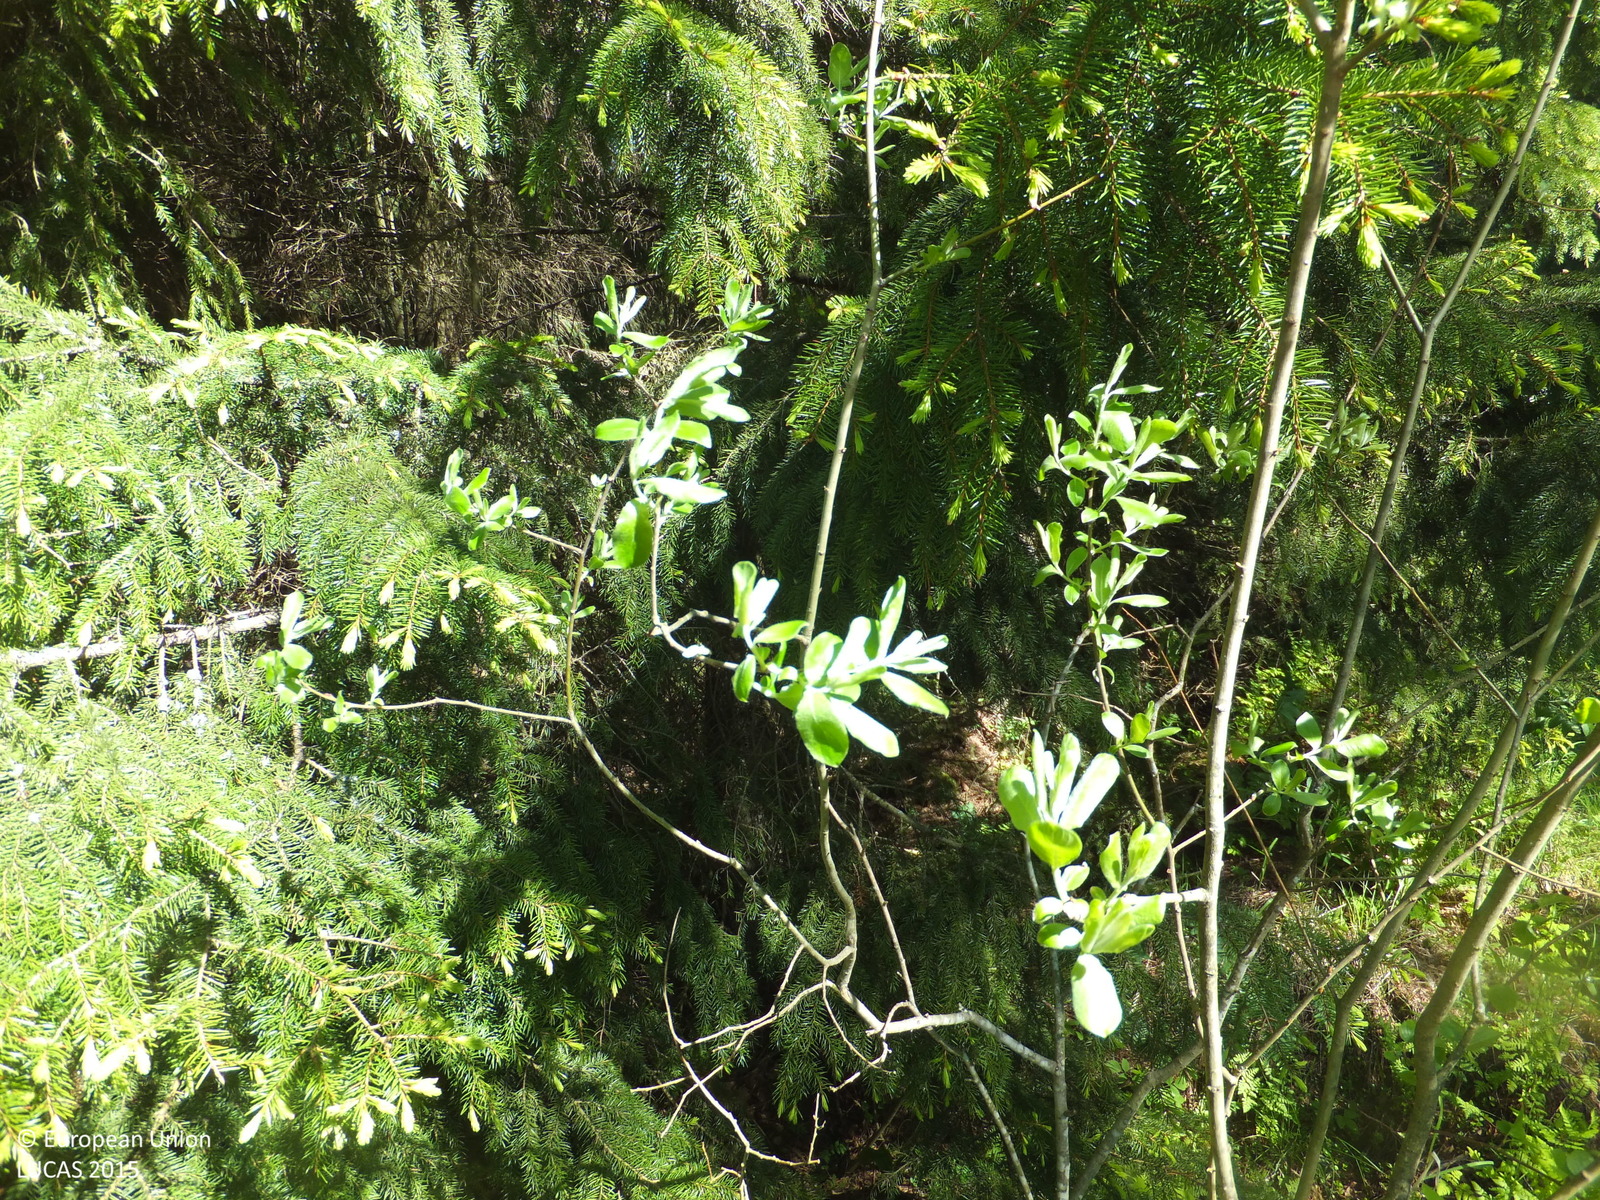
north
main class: Woodland
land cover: Spruce dominated mixed woodland
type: boreal forest
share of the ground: 50 - 75 %
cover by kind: coniferous forest trees 30 %, broadleaved forest trees 30 %, shrubs 20 %, herbaceous plants 10 %, lichens and mosses 10 %
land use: Forestry
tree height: > 5 m
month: June
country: FI
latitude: 63.6445
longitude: 22.9535
